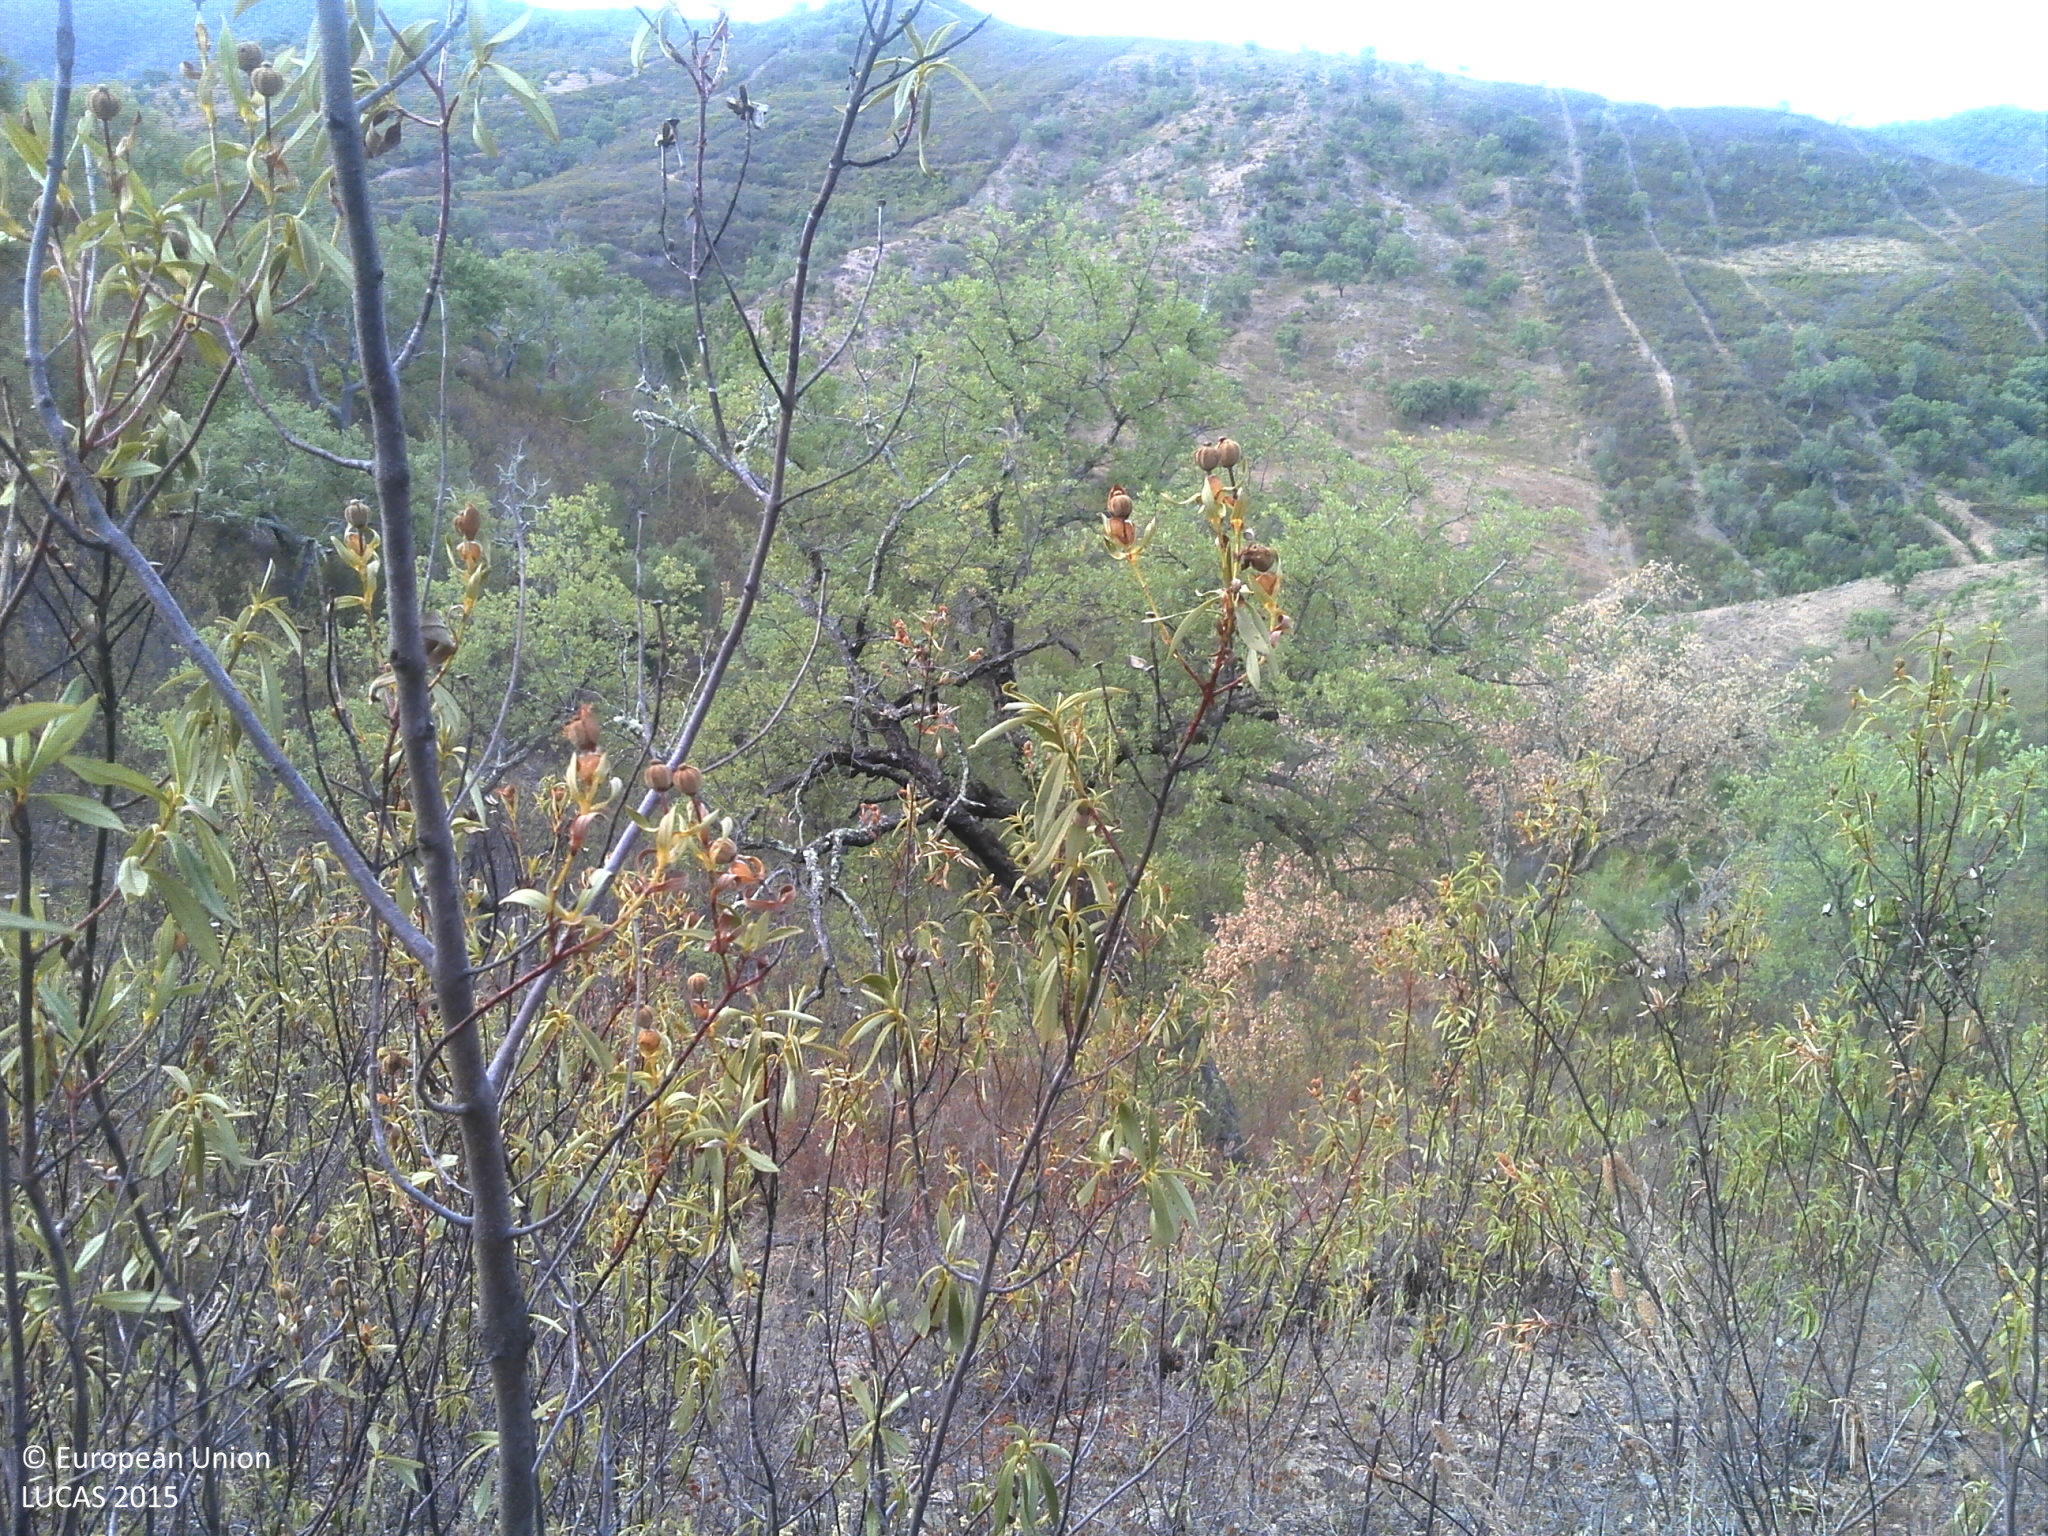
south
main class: Woodland
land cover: Broadleaved woodland
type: broadleaved evergreen forest
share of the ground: 10 - 25 %
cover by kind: shrubs 40 %, unconsolidated bare surface 30 %, broadleaved forest trees 20 %, herbaceous plants 10 %
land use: Forestry
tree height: < 5 m
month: September
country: PT
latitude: 37.3003
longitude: -8.1491
